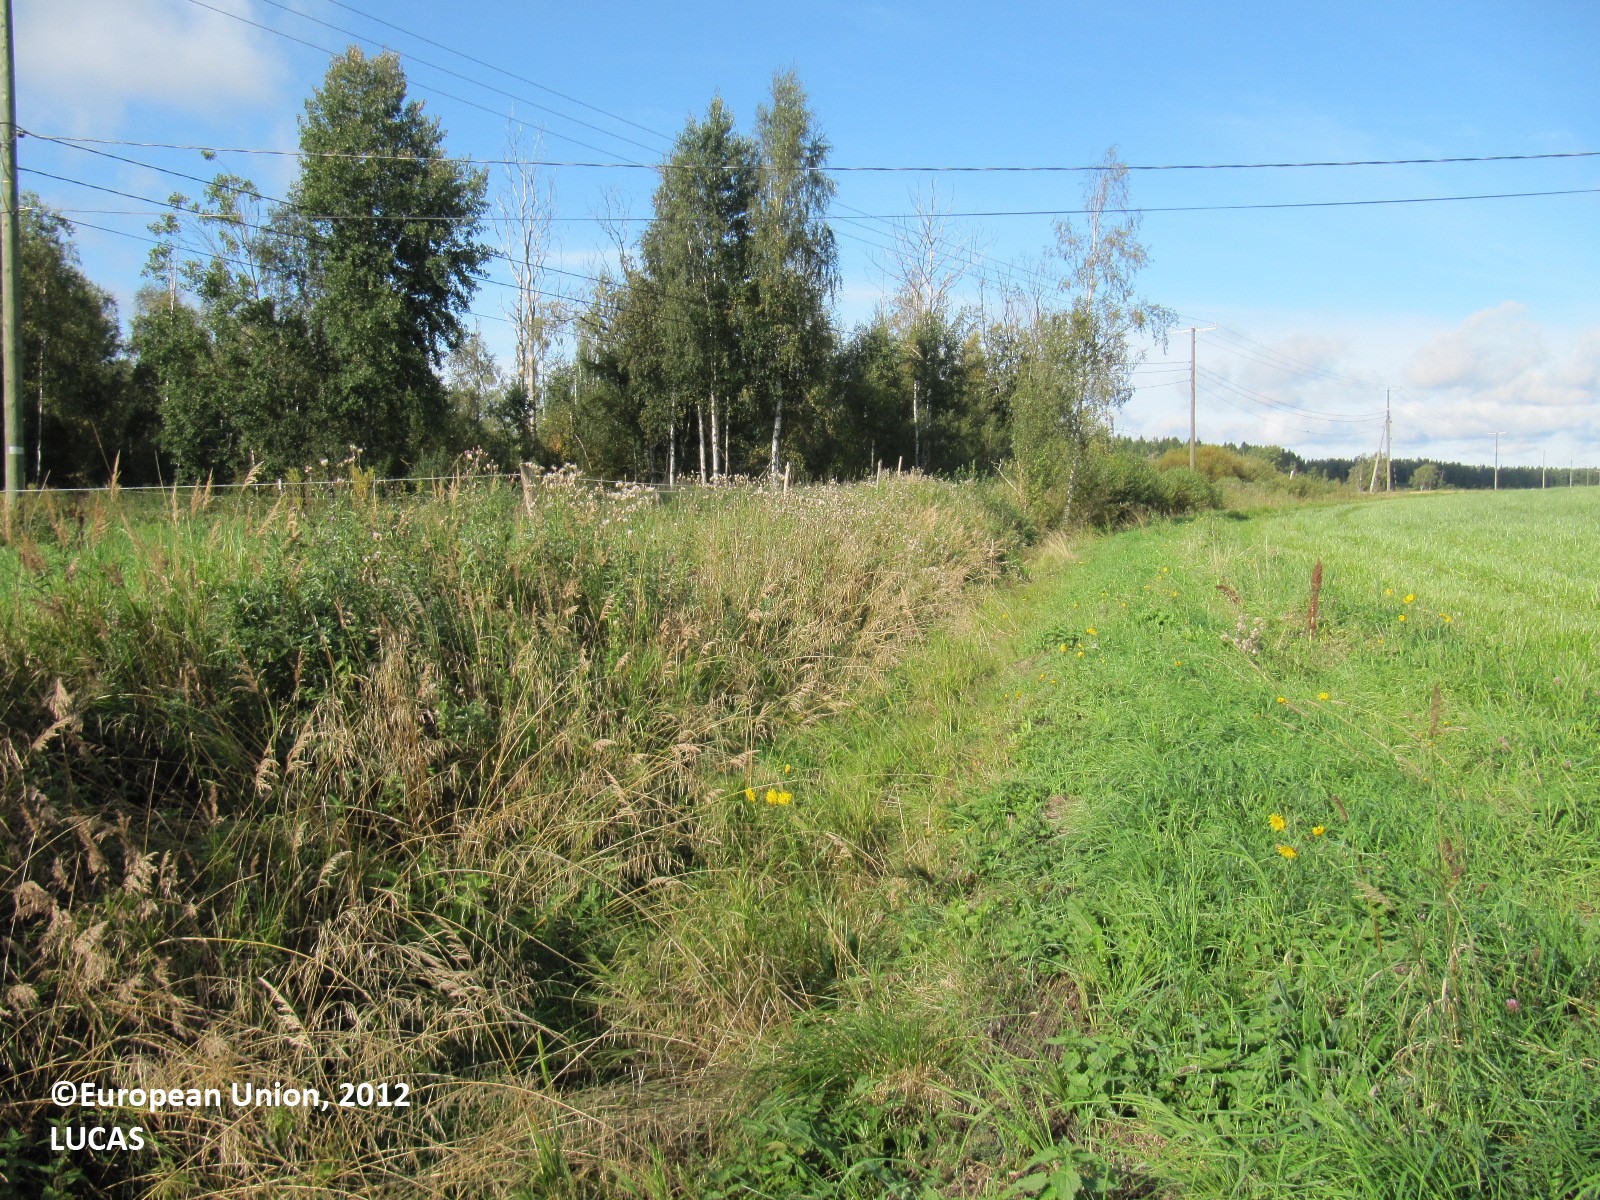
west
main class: Grassland
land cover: Grassland without tree/shrub cover
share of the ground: > 75 %
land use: Fallow land
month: September
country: FI
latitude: 60.7857
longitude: 23.3618
